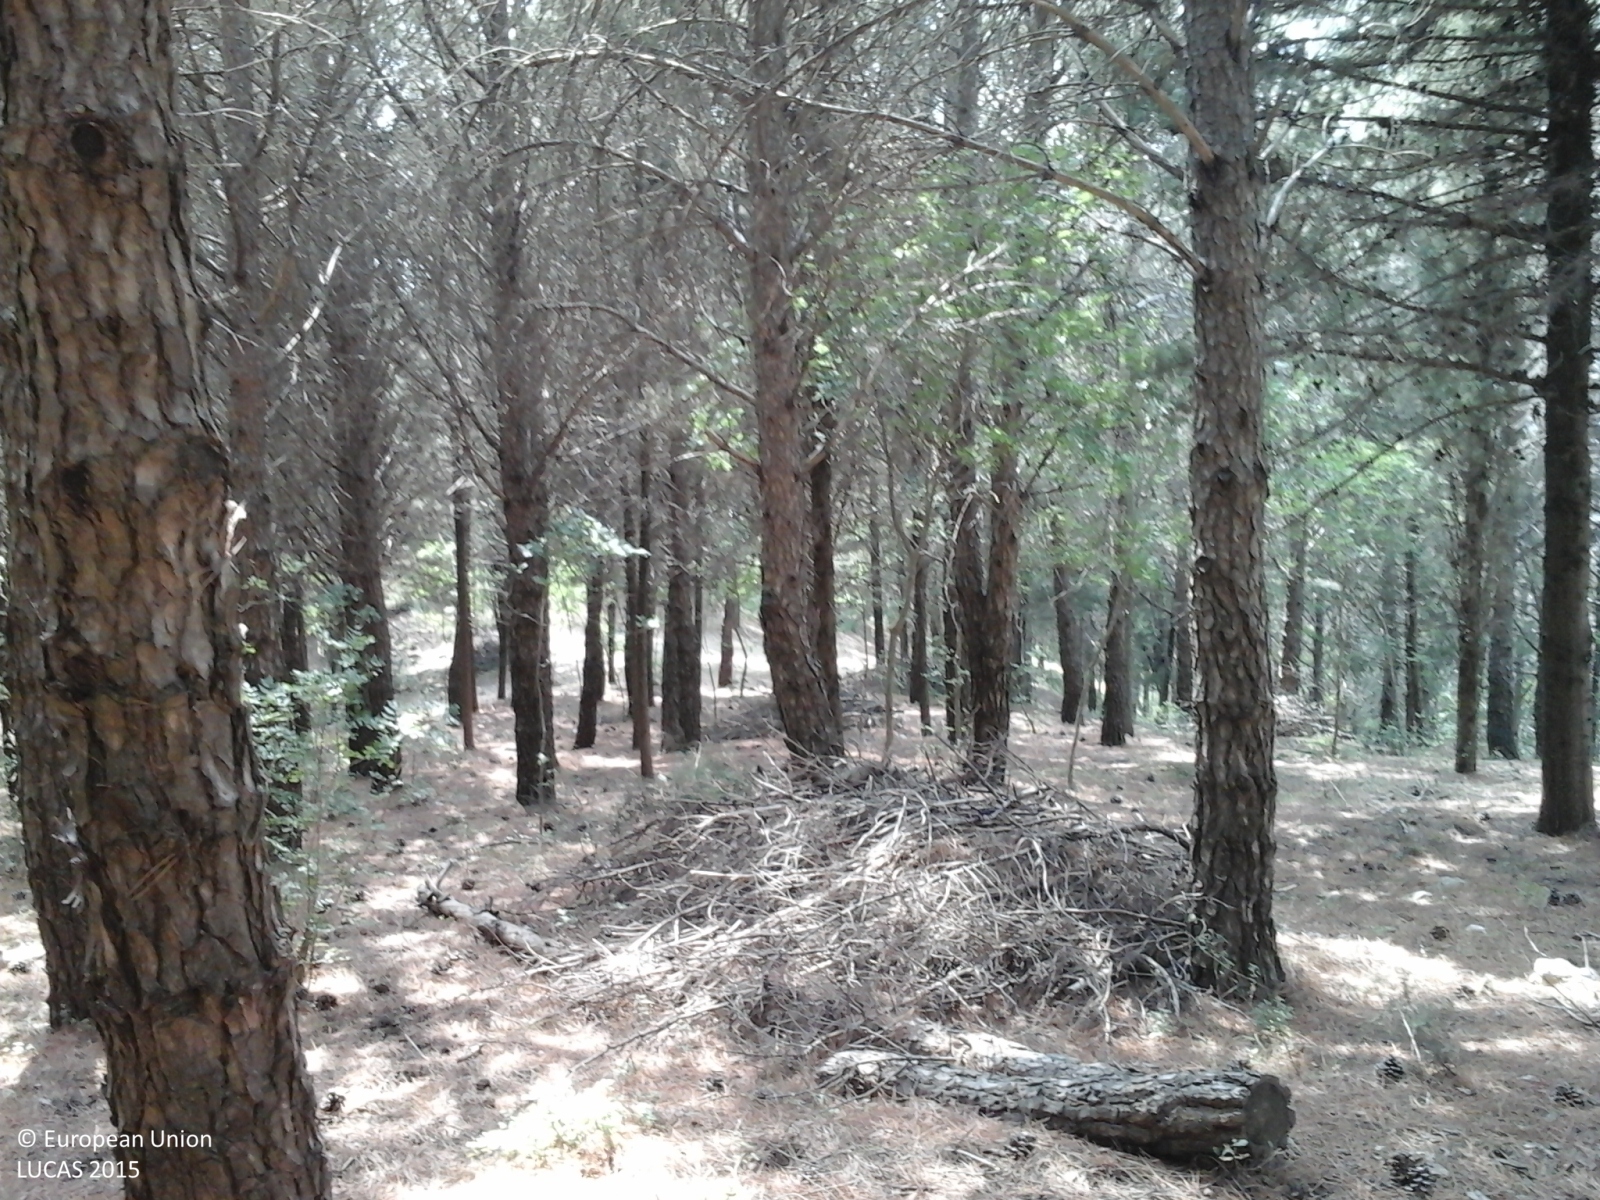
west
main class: Woodland
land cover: Pine dominated coniferous woodland
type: coniferous forest of the mediterranean region
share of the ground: > 75 %
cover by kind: coniferous forest trees 90 %, consolidated bare surface 10 %
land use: Forestry
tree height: > 5 m
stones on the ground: < 10 %
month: July
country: IT
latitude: 37.6106
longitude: 13.4969
